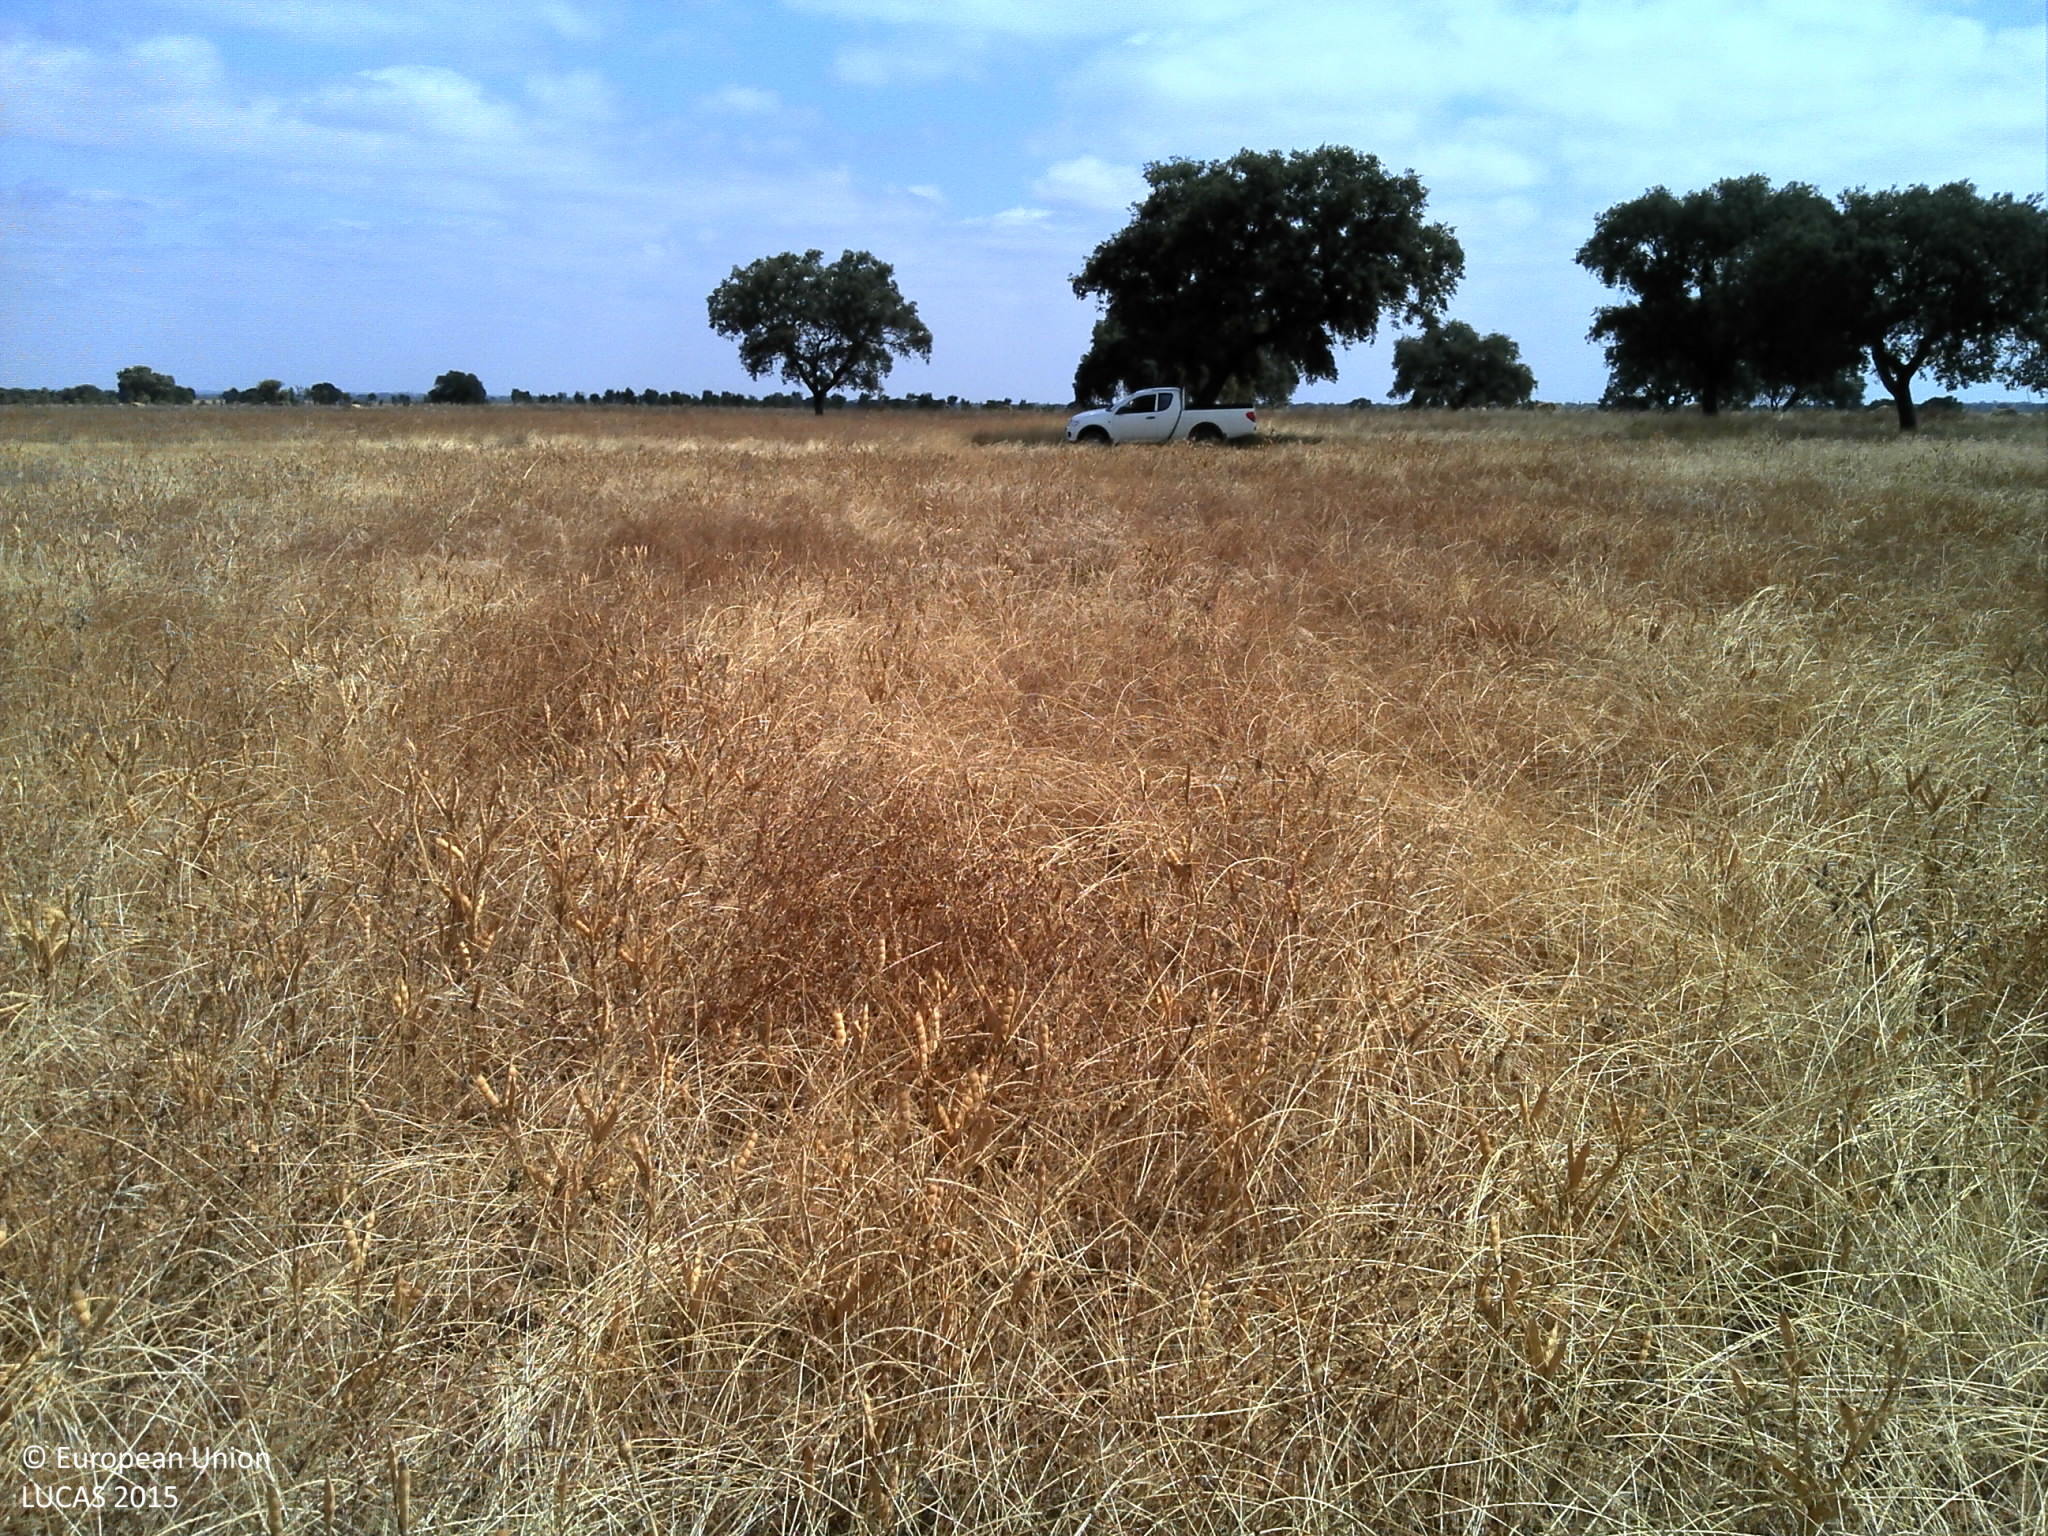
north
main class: Grassland
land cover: Grassland without tree/shrub cover
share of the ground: > 75 %
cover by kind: herbaceous plants 90 %, unconsolidated bare surface 10 %
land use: Agriculture (excluding fallow land and kitchen gardens)
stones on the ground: < 10 %
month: June
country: PT
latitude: 37.8410
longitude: -8.3189
